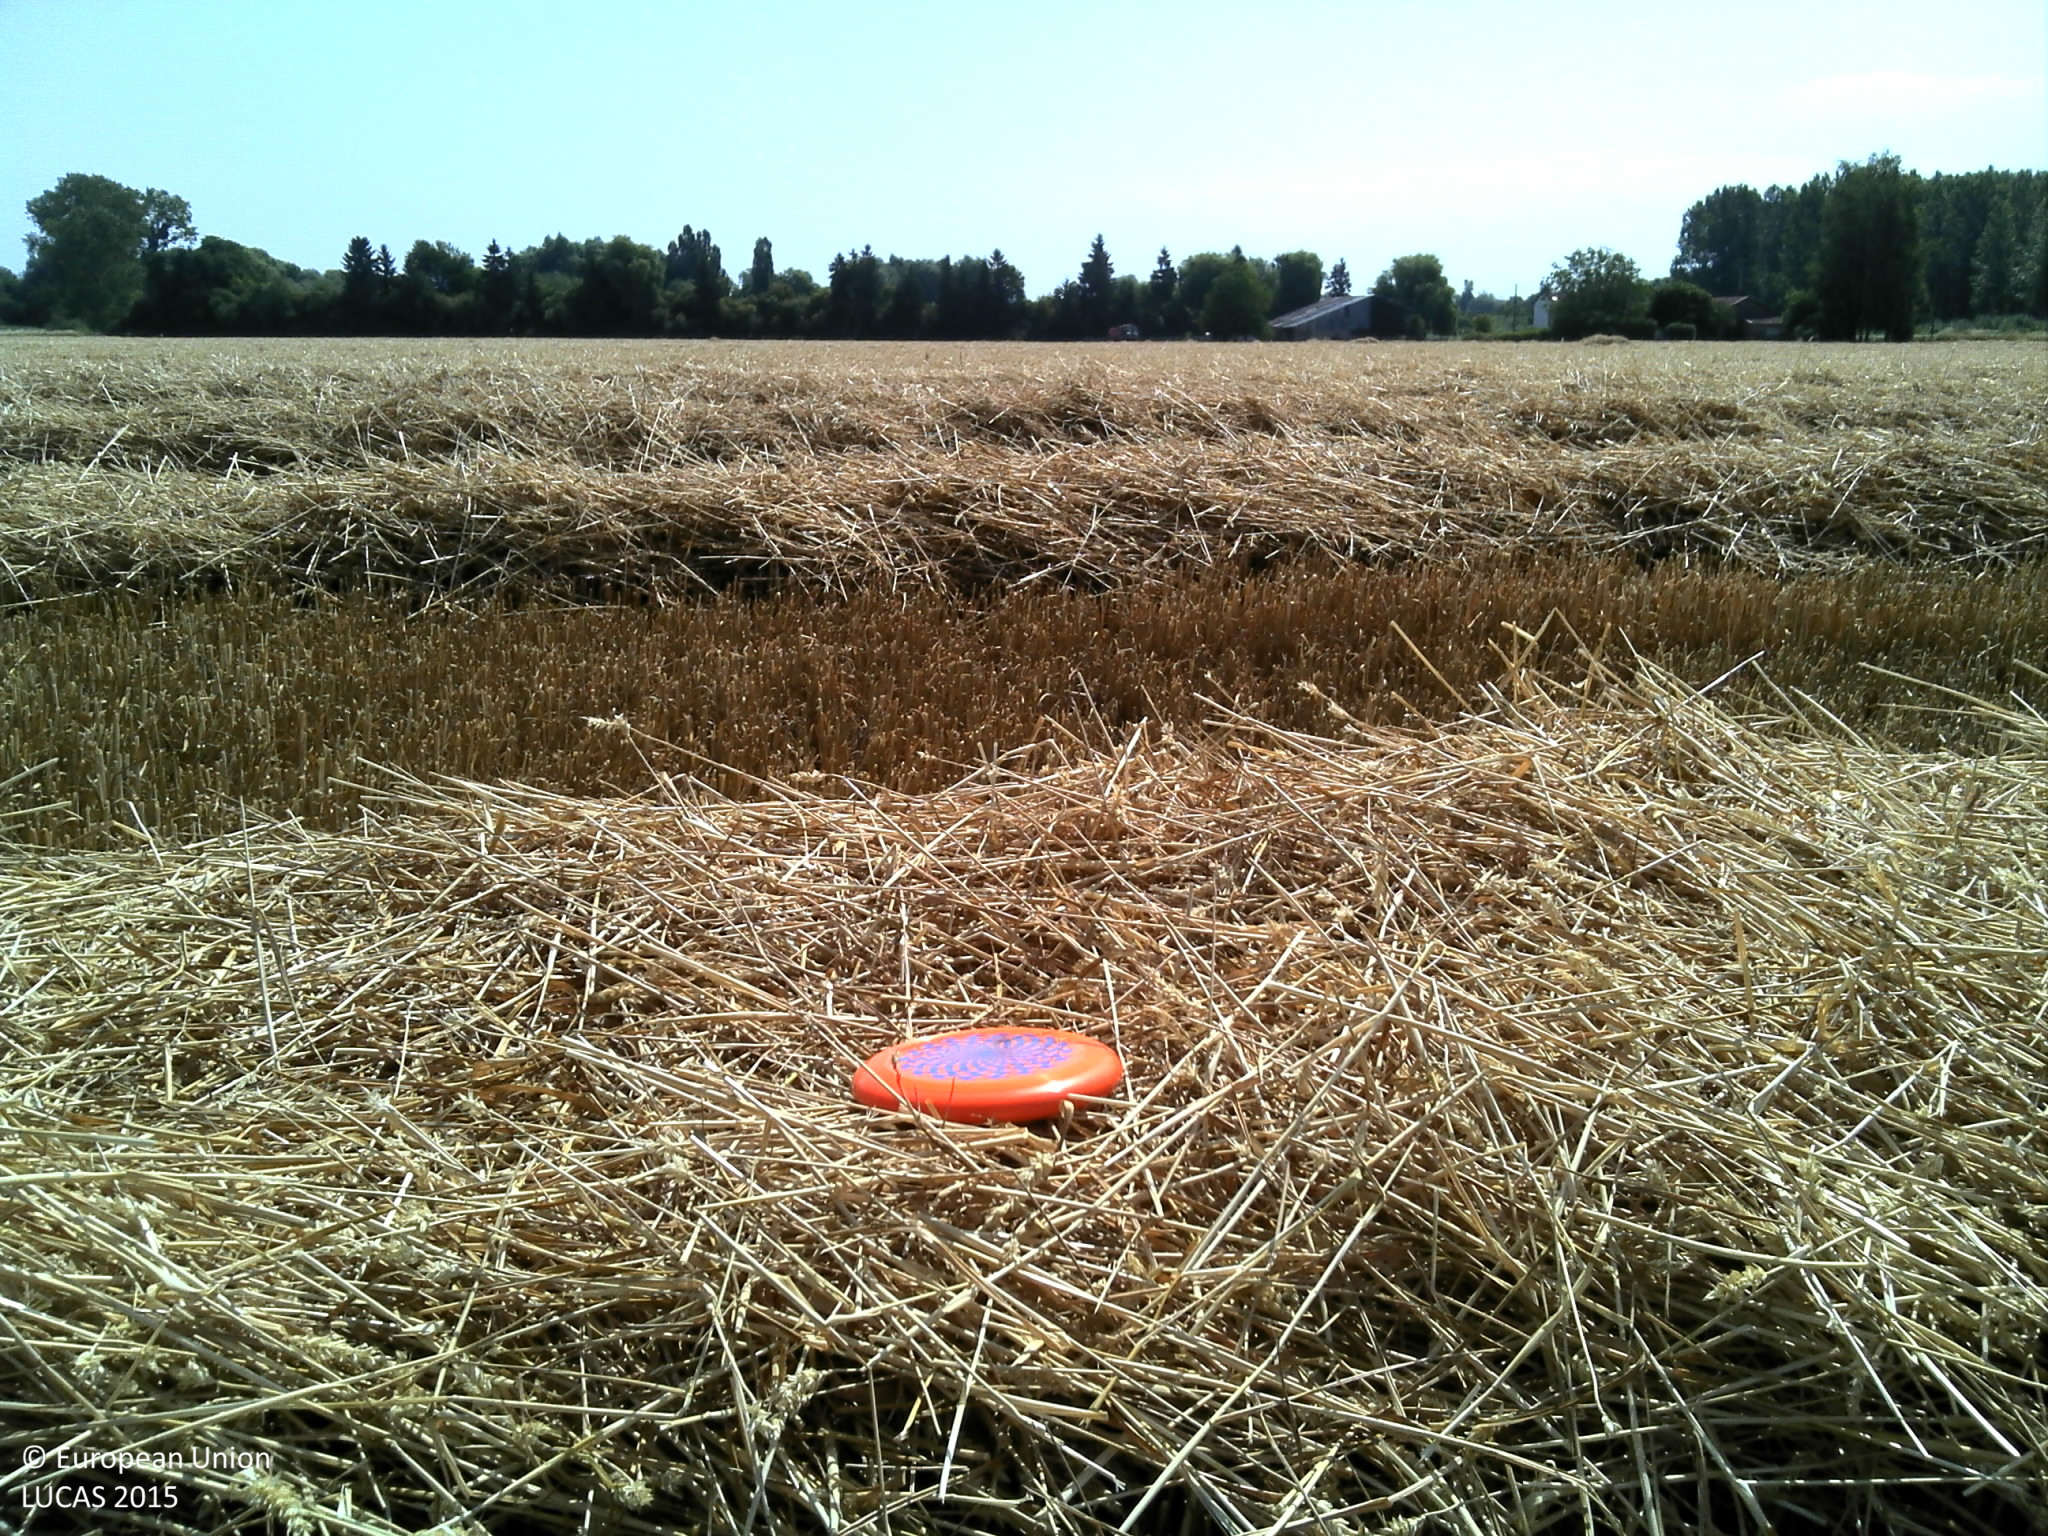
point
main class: Cropland
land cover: Common wheat
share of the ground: > 75 %
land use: Agriculture (excluding fallow land and kitchen gardens)
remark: Harvested field
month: July
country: FR
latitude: 48.7903
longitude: 4.8935
